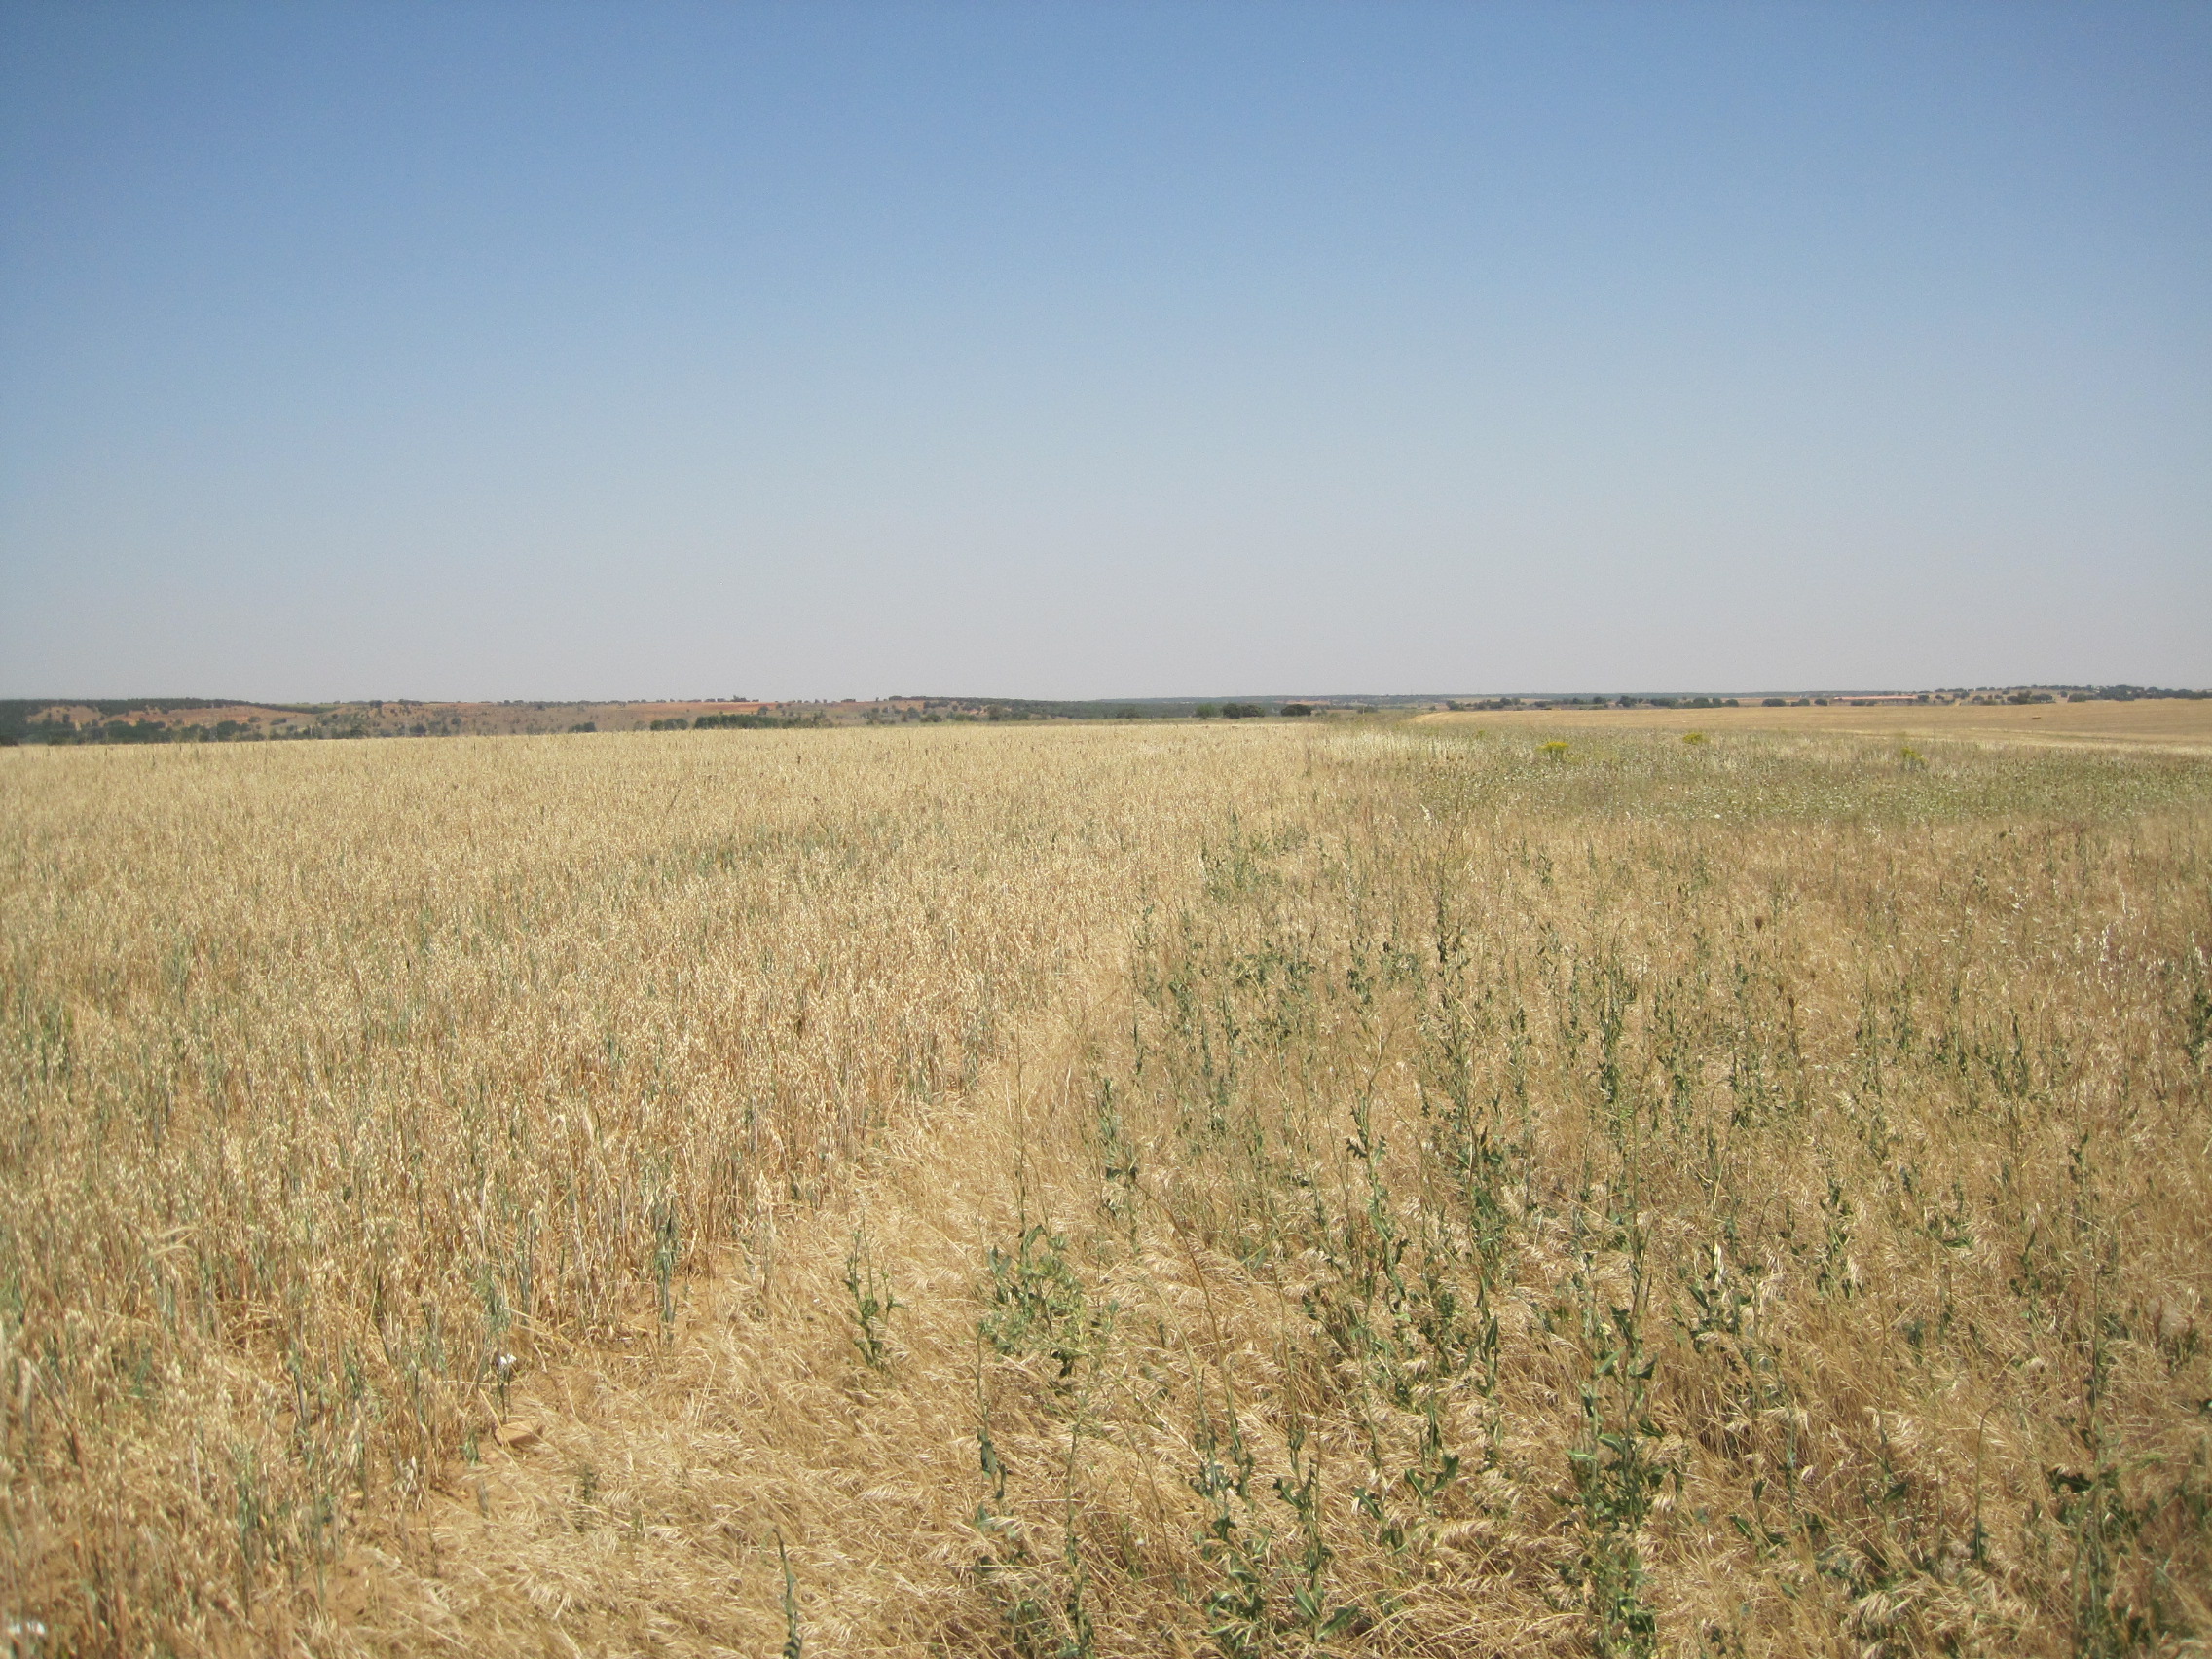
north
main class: Grassland
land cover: Spontaneously vegetated surfaces
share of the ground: > 75 %
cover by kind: herbaceous plants 100 %
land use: Abandoned areas
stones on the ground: 25 - 50 %
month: July
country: ES
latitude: 41.7023
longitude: -5.4284
